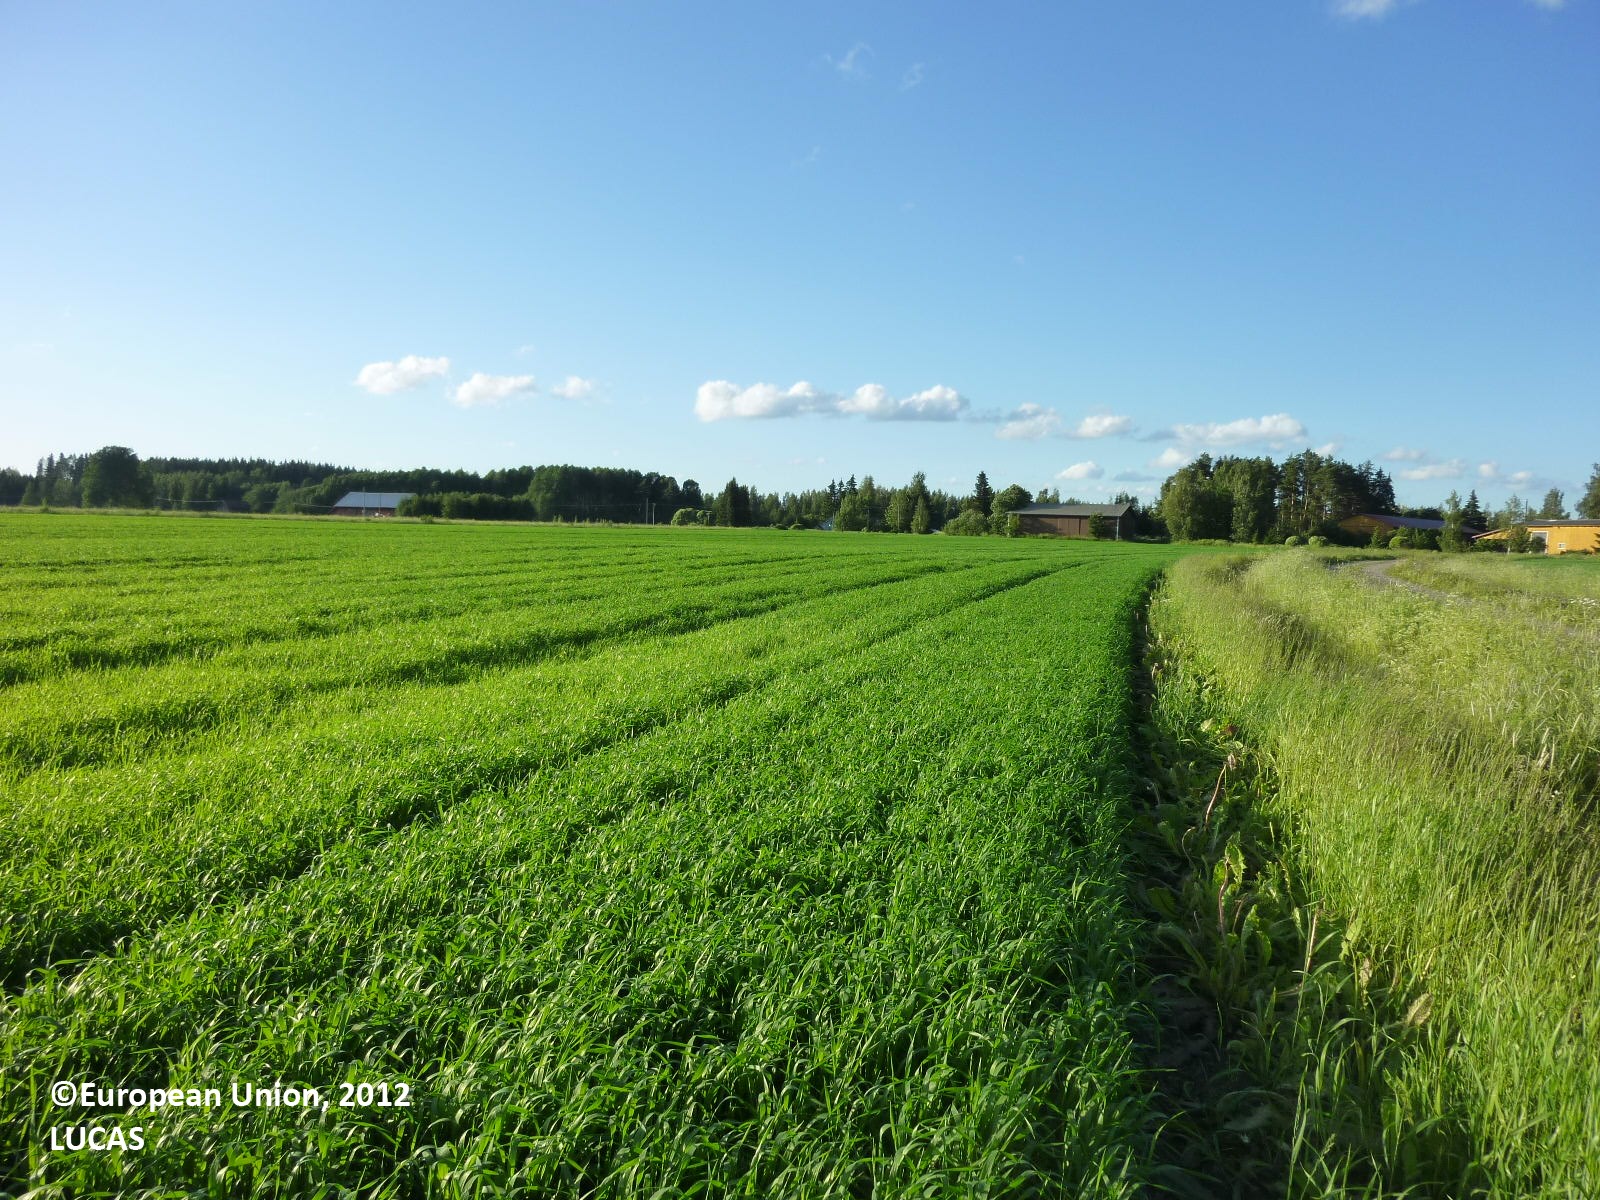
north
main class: Cropland
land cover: Barley
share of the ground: > 75 %
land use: Agriculture (excluding fallow land and kitchen gardens)
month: July
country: FI
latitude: 61.1920
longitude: 22.5113
